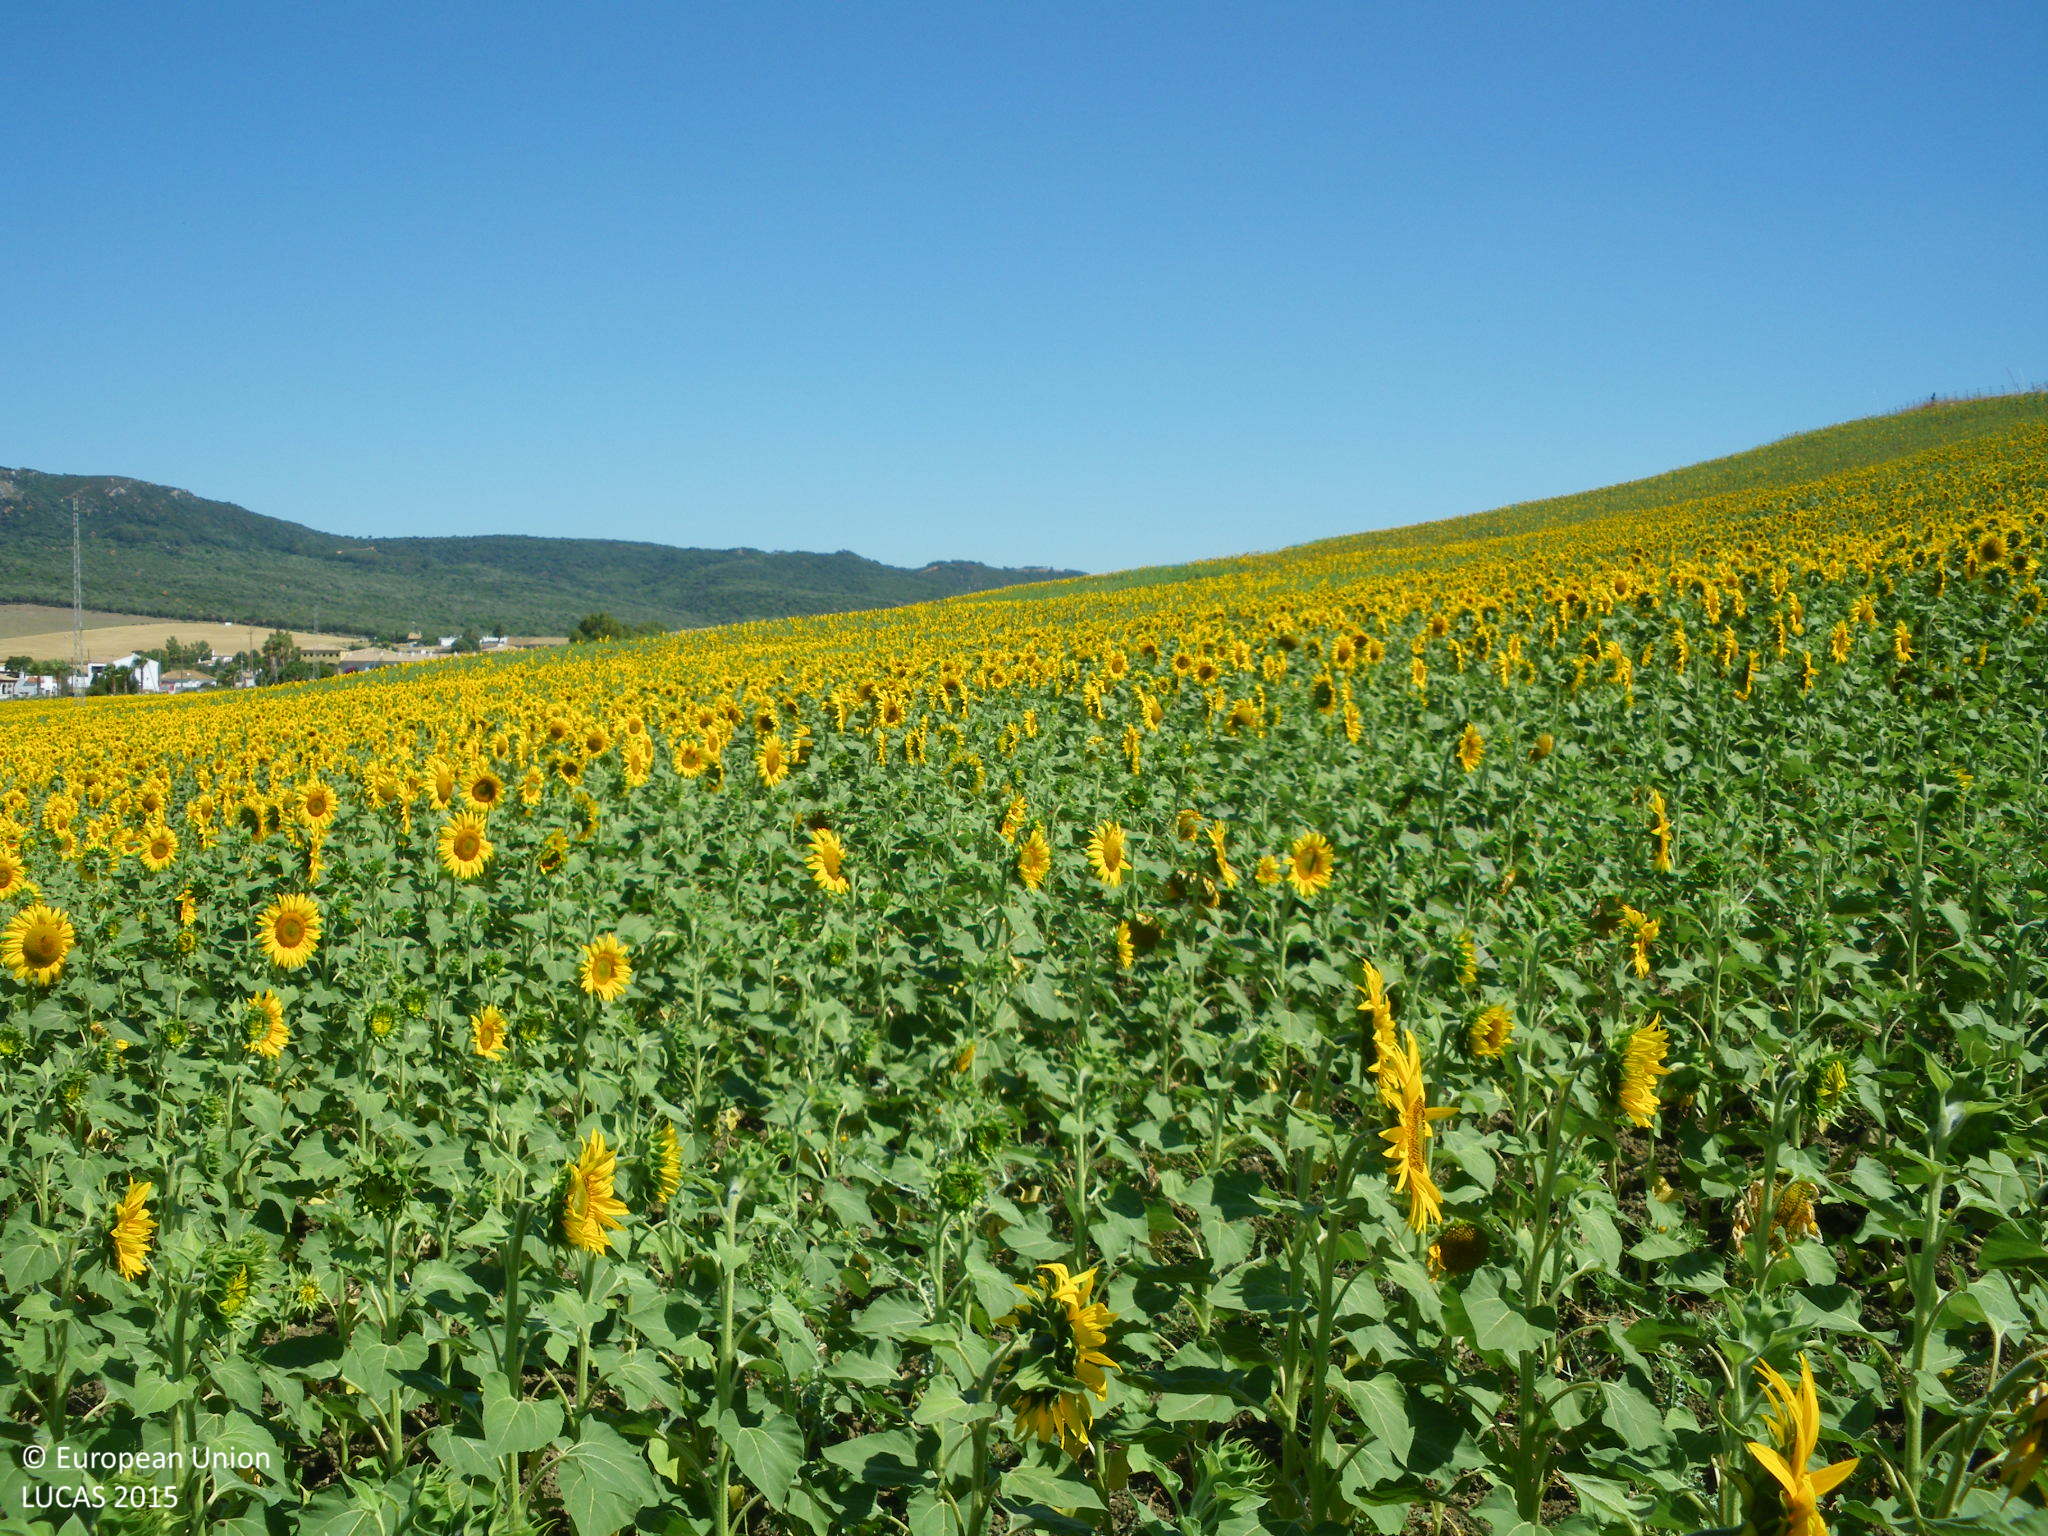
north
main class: Cropland
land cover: Sunflower
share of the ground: > 75 %
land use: Agriculture (excluding fallow land and kitchen gardens)
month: June
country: ES
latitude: 36.1570
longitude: -5.8140
